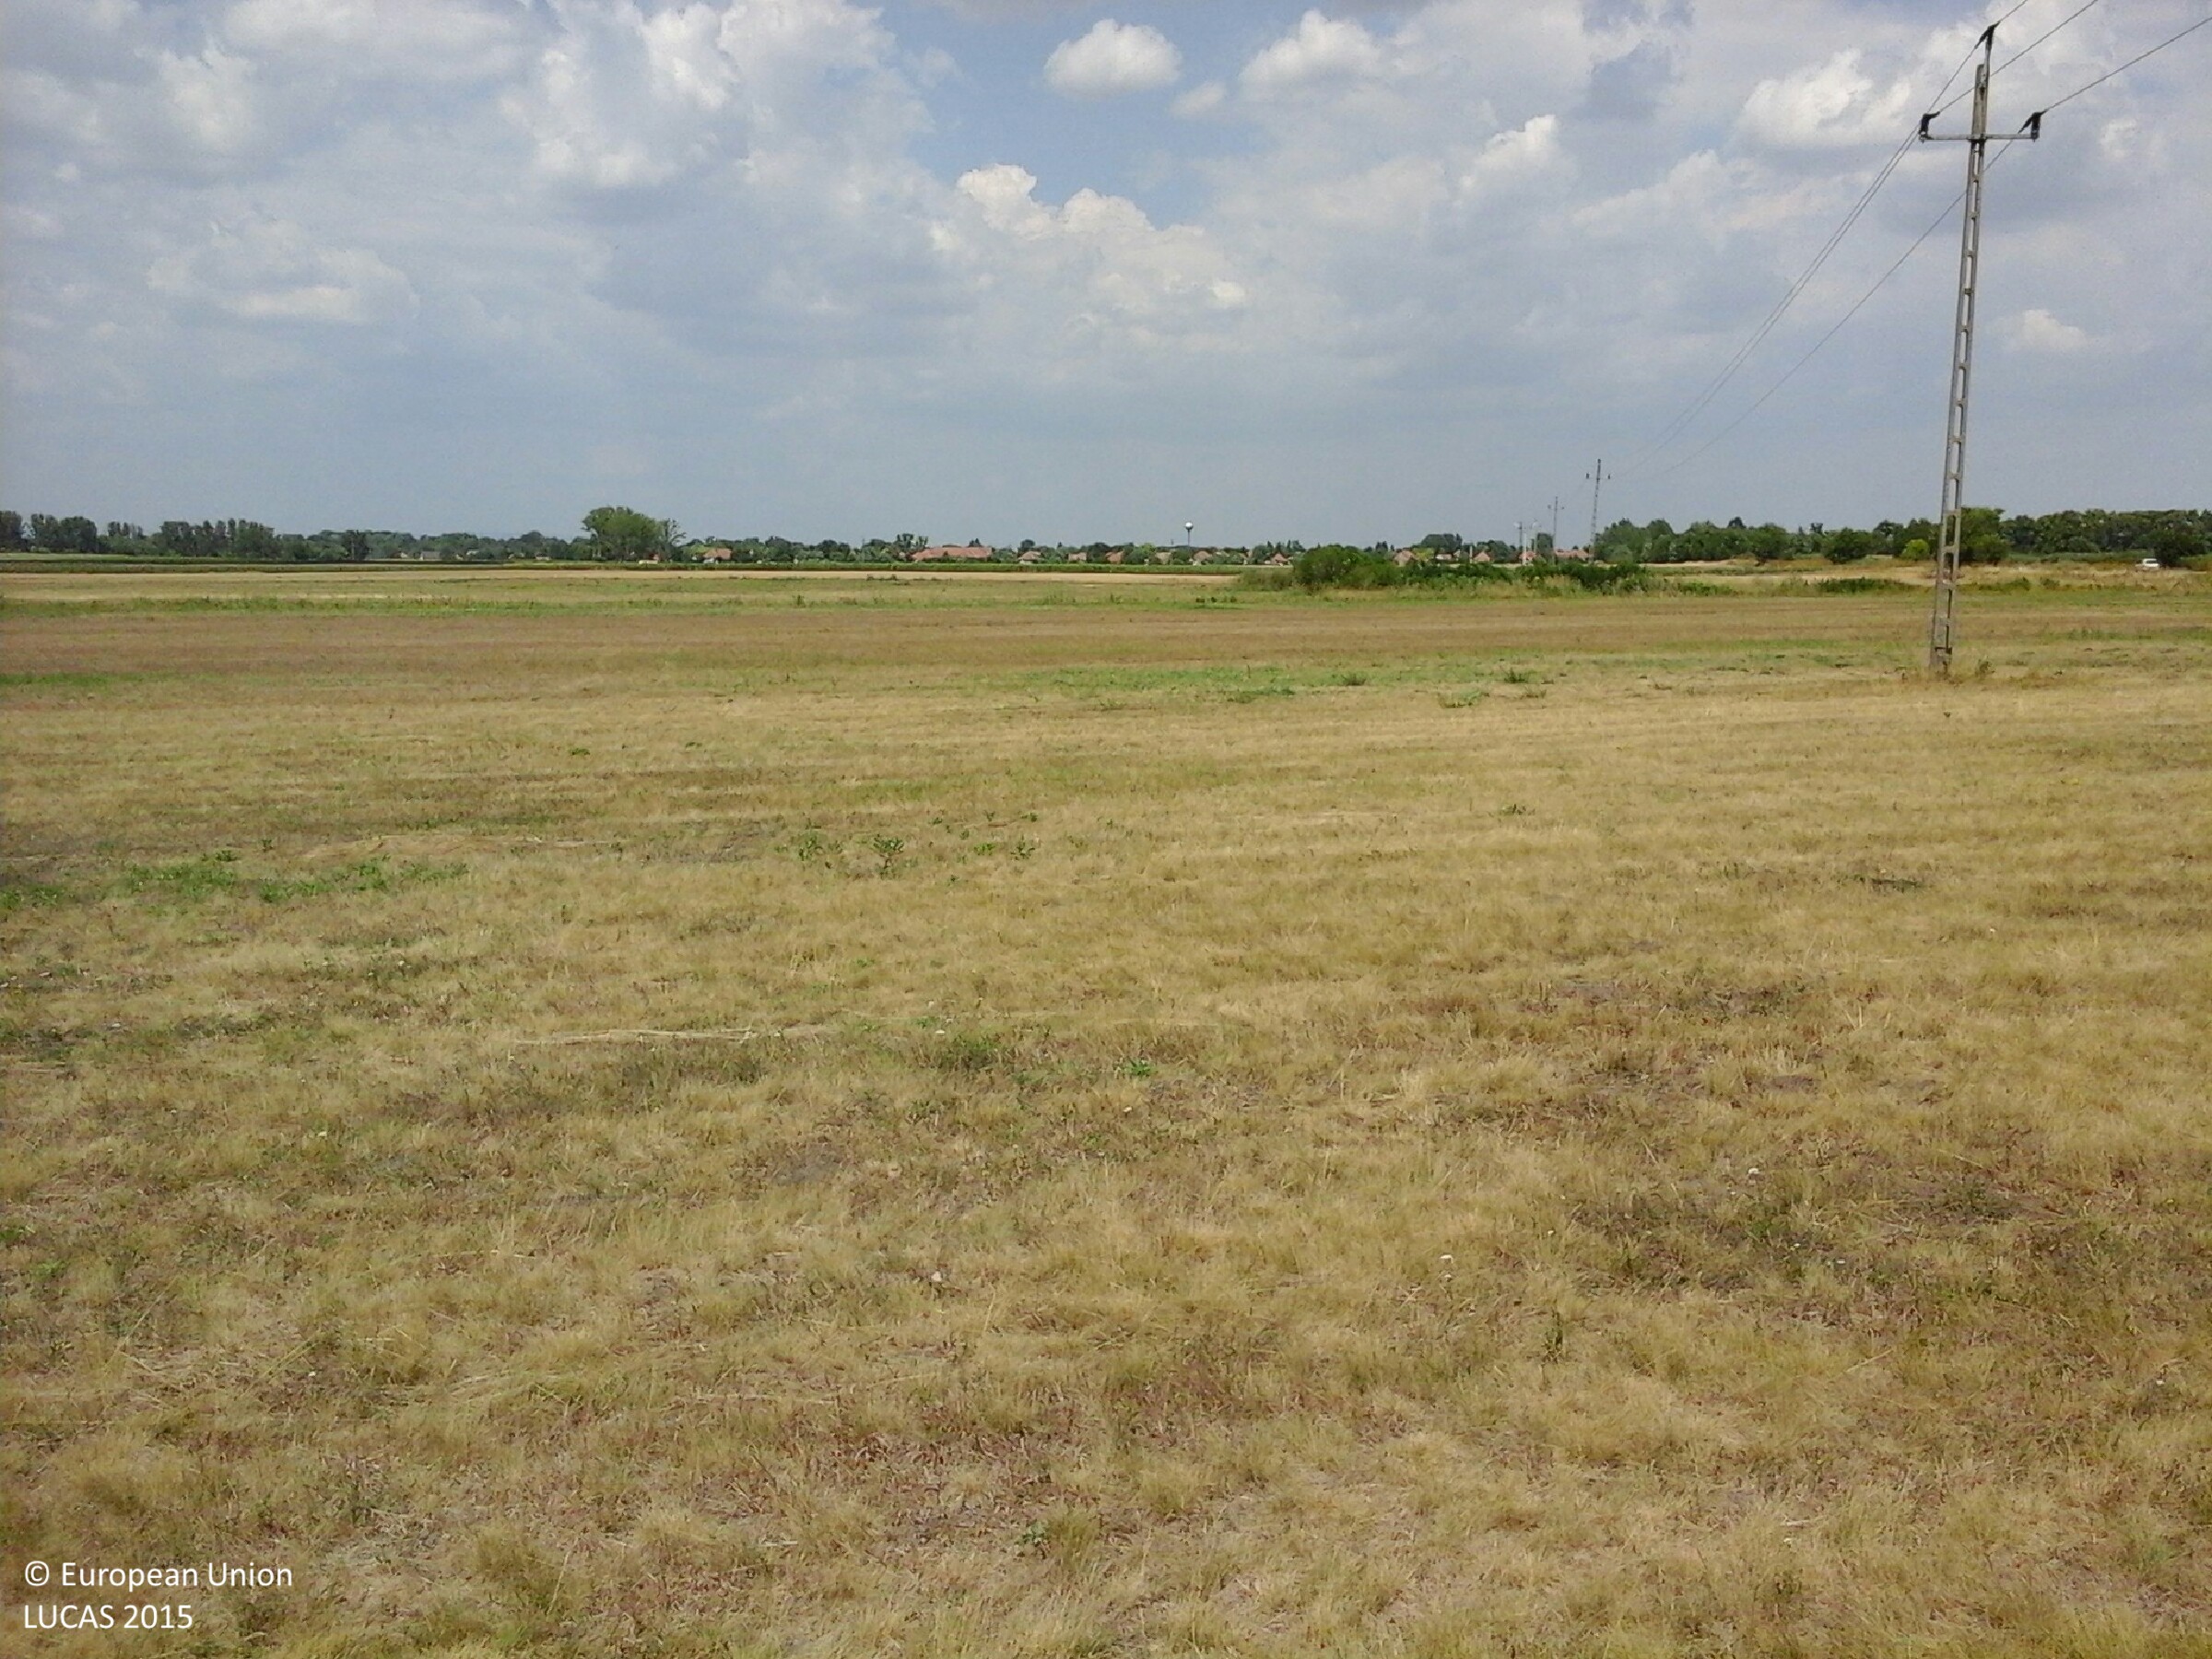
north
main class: Grassland
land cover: Grassland without tree/shrub cover
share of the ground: > 75 %
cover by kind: herbaceous plants 100 %
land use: Agriculture (excluding fallow land and kitchen gardens)
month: July
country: HU
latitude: 47.6878
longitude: 20.6516
